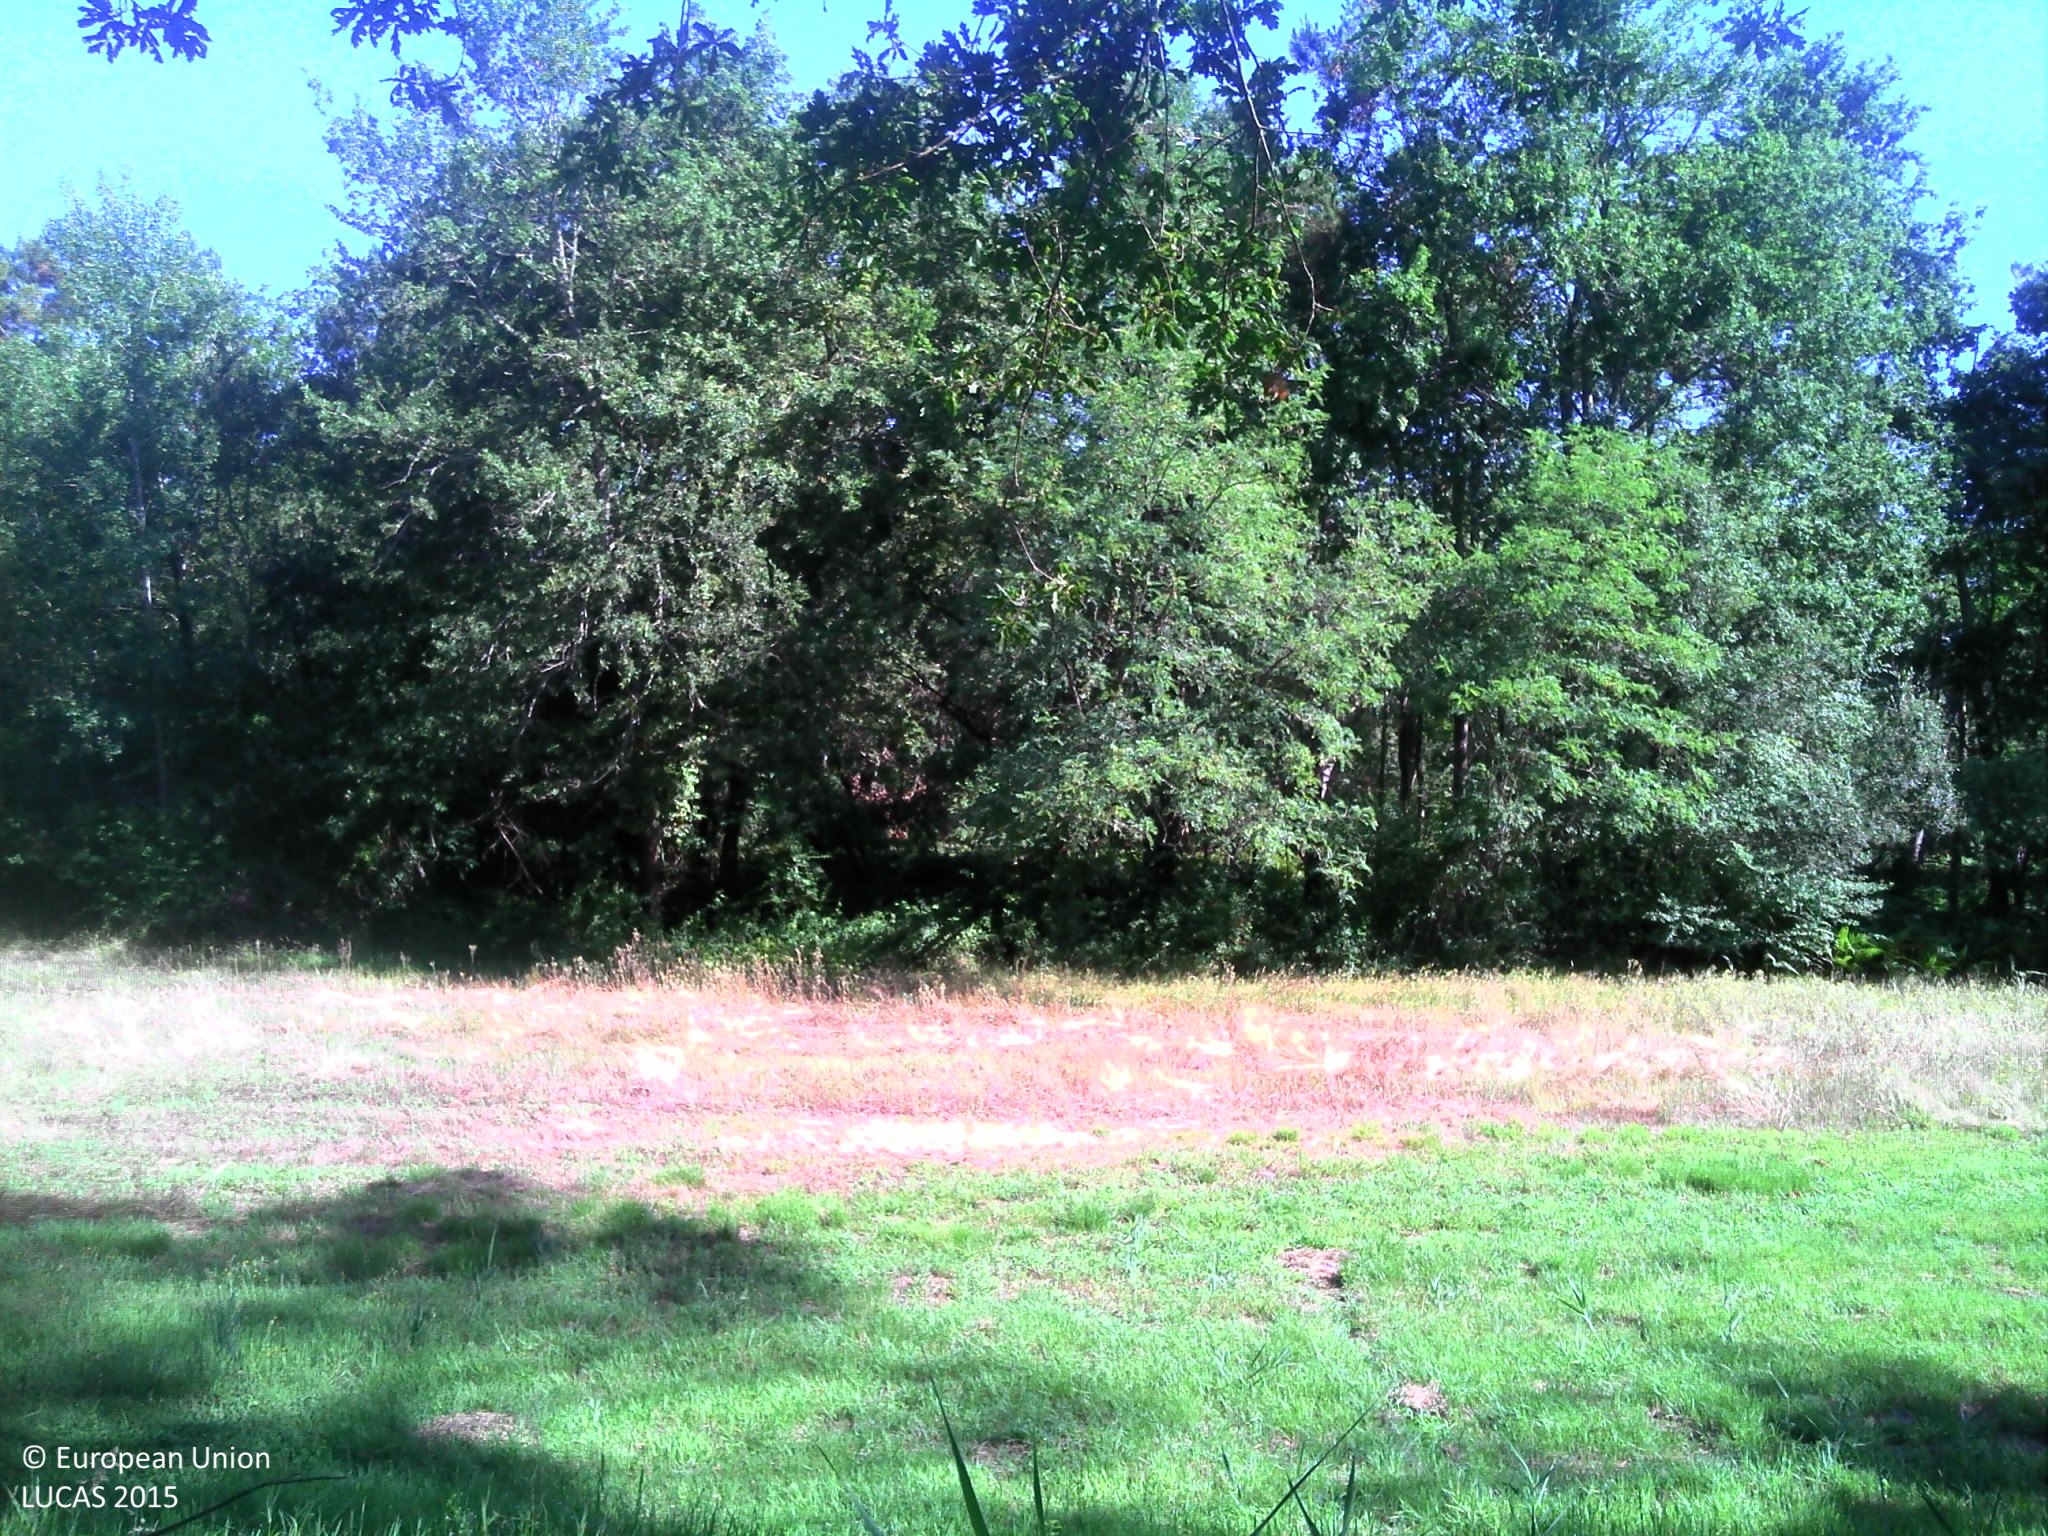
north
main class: Woodland
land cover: Broadleaved woodland
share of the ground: > 75 %
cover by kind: broadleaved forest trees 50 %, herbaceous plants 40 %, shrubs 10 %
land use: Semi-natural and natural areas not in use
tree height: > 5 m
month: July
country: FR
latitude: 43.8988
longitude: -0.5825
